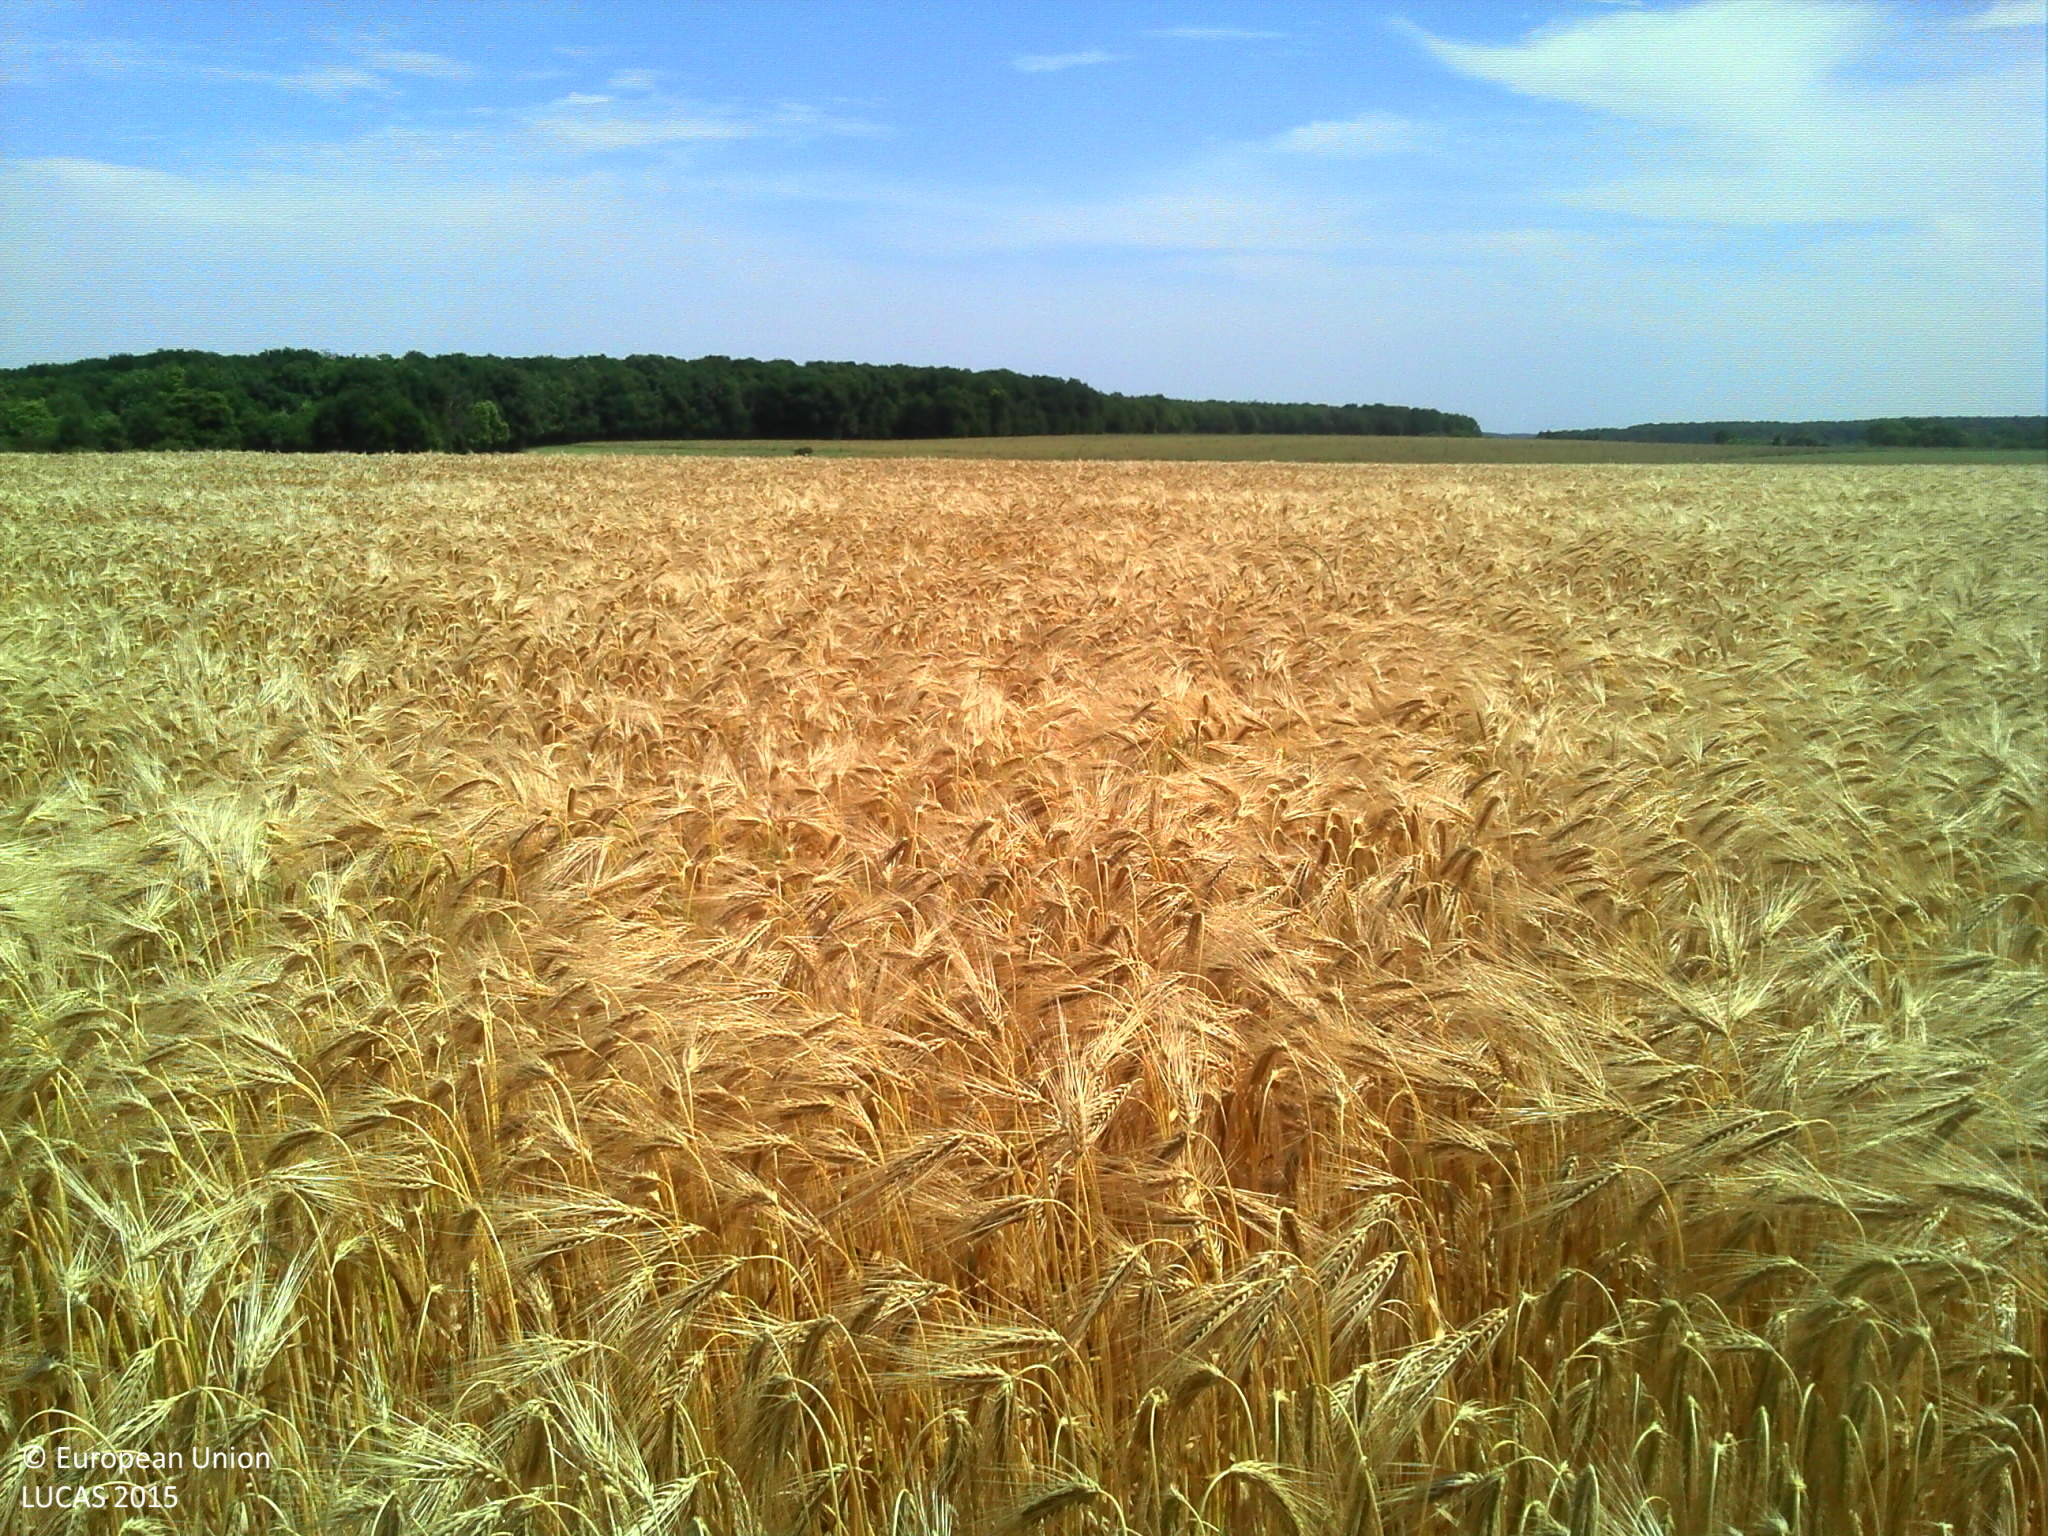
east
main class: Cropland
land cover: Barley
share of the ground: > 75 %
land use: Agriculture (excluding fallow land and kitchen gardens)
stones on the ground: 10 - 25 %
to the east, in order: Barley; Grass margins; Tracks; Grass margins; Rape and turnip rape
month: June
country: FR
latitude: 49.1017
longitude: 1.2002
